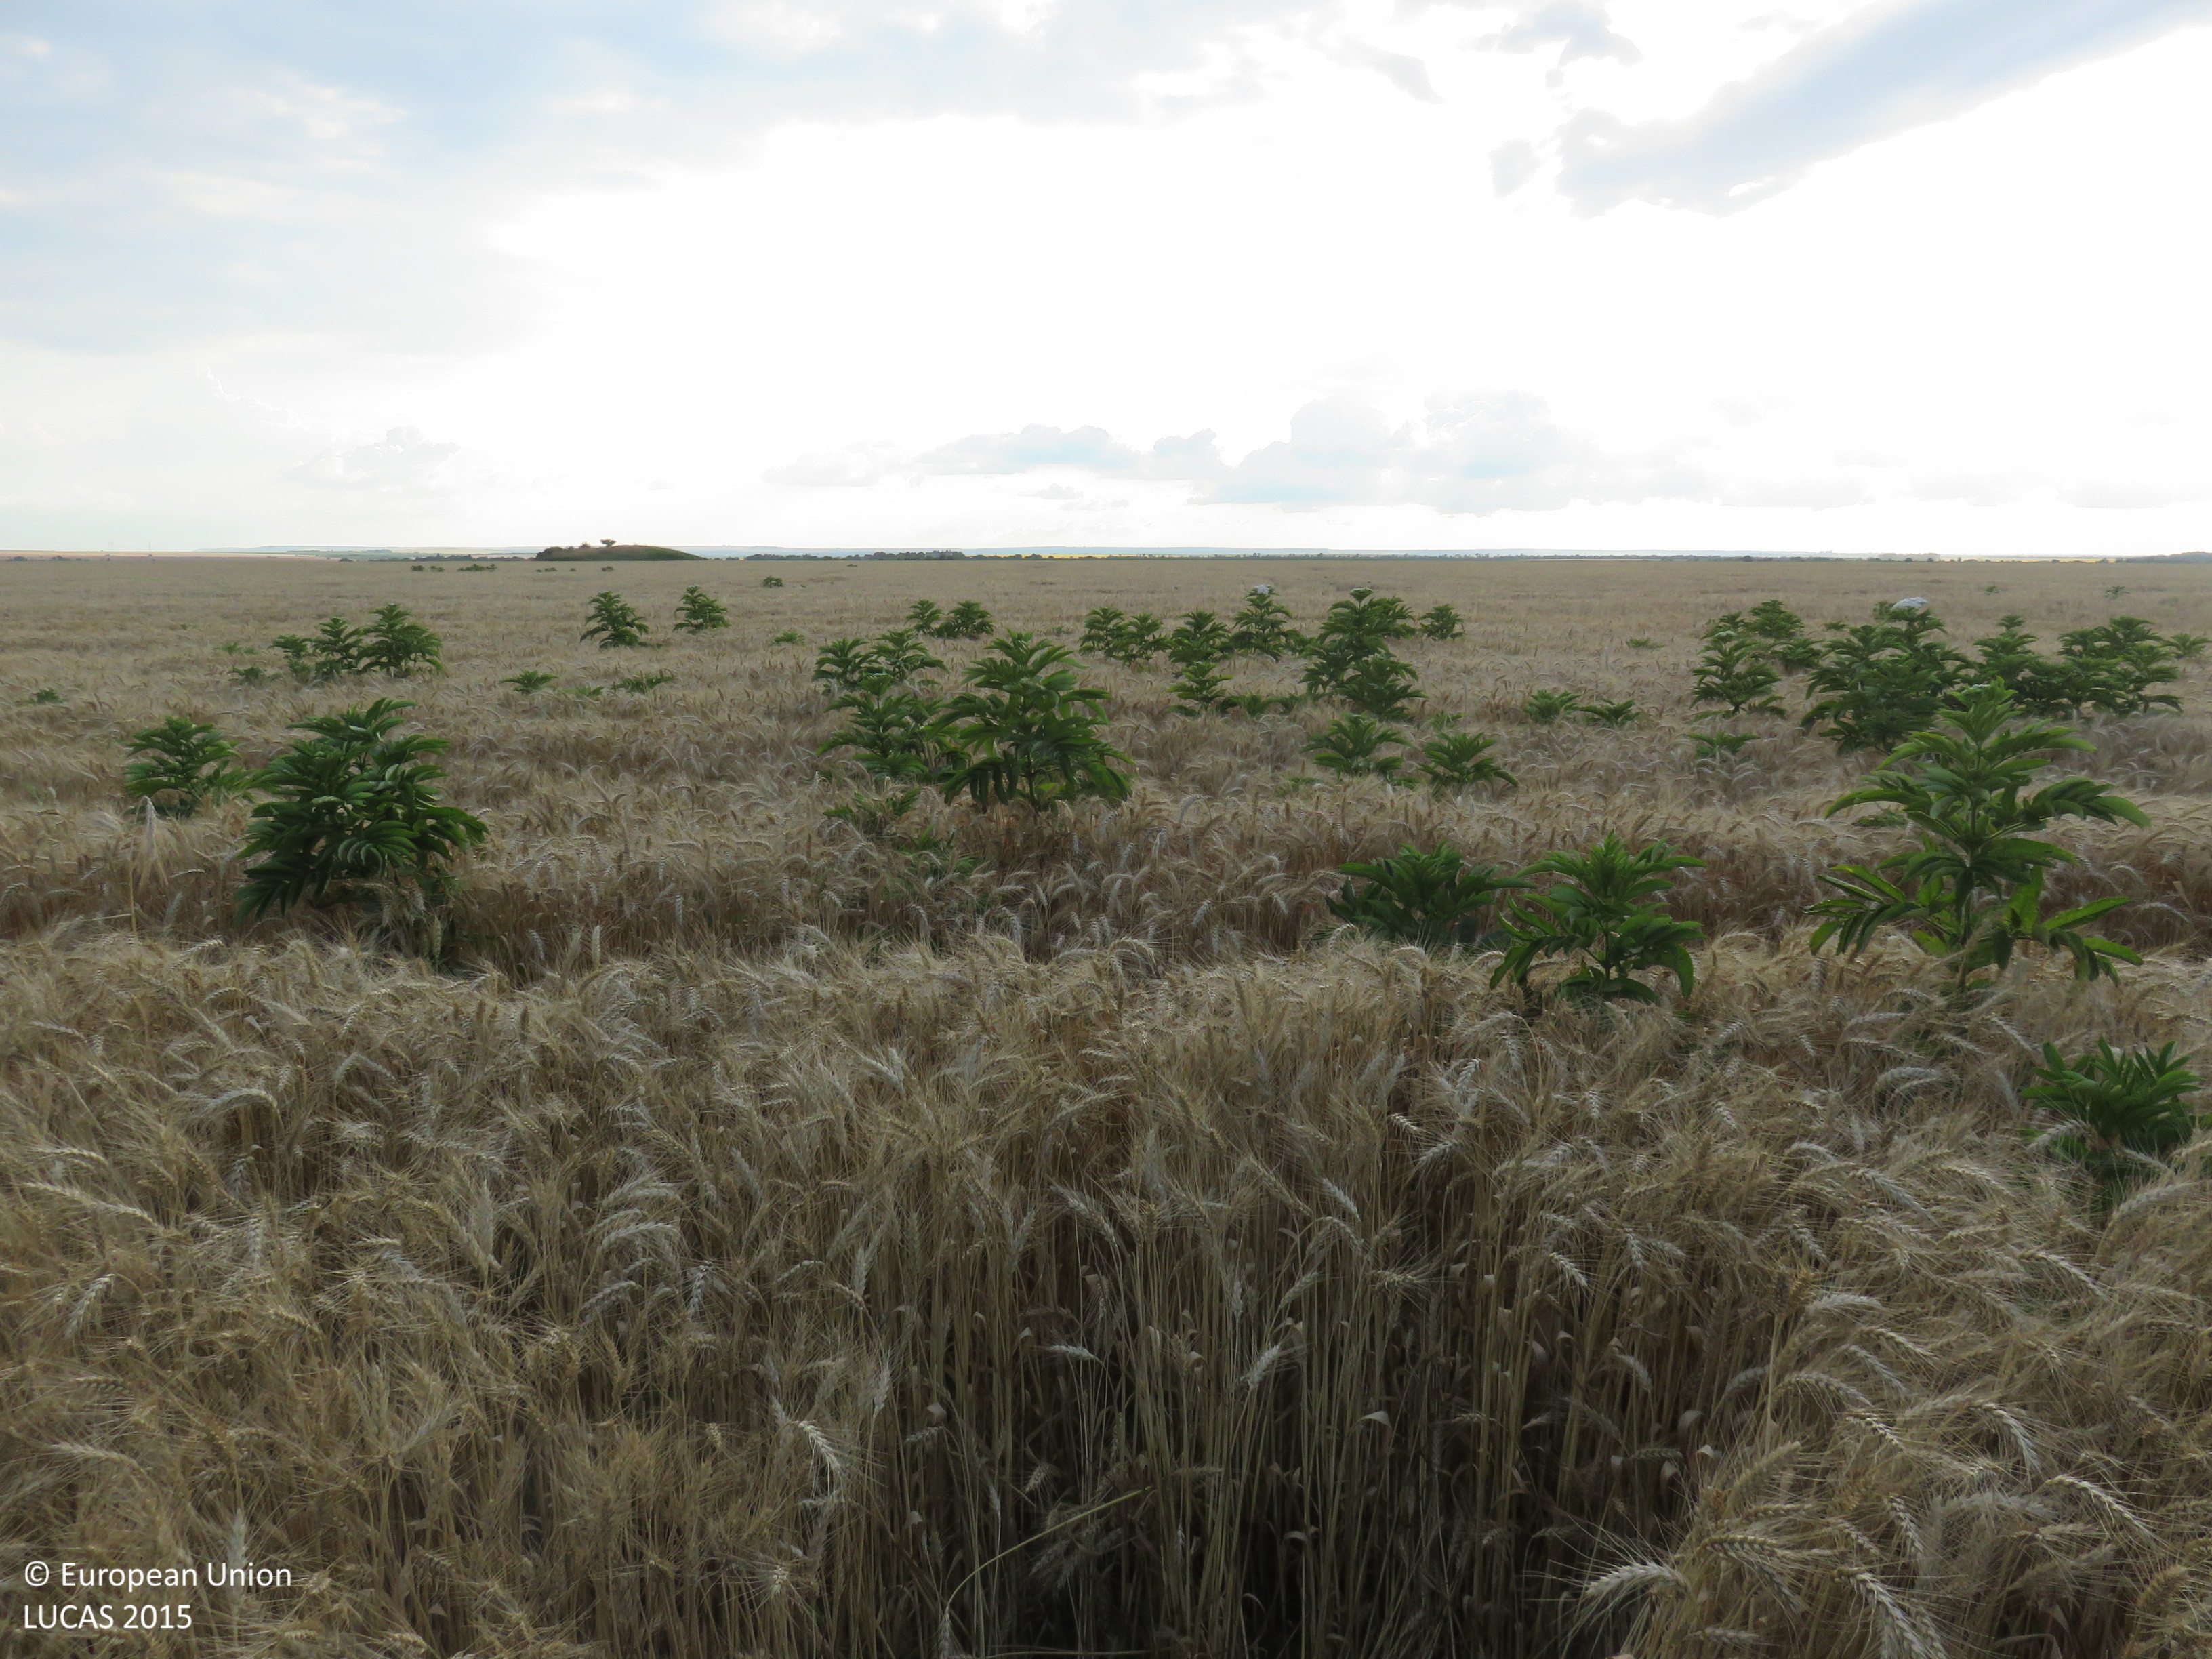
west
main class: Cropland
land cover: Common wheat
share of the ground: > 75 %
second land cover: Spontaneously vegetated surfaces
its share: < 10 %
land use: Agriculture (excluding fallow land and kitchen gardens)
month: June
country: BG
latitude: 43.3505
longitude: 24.9597
